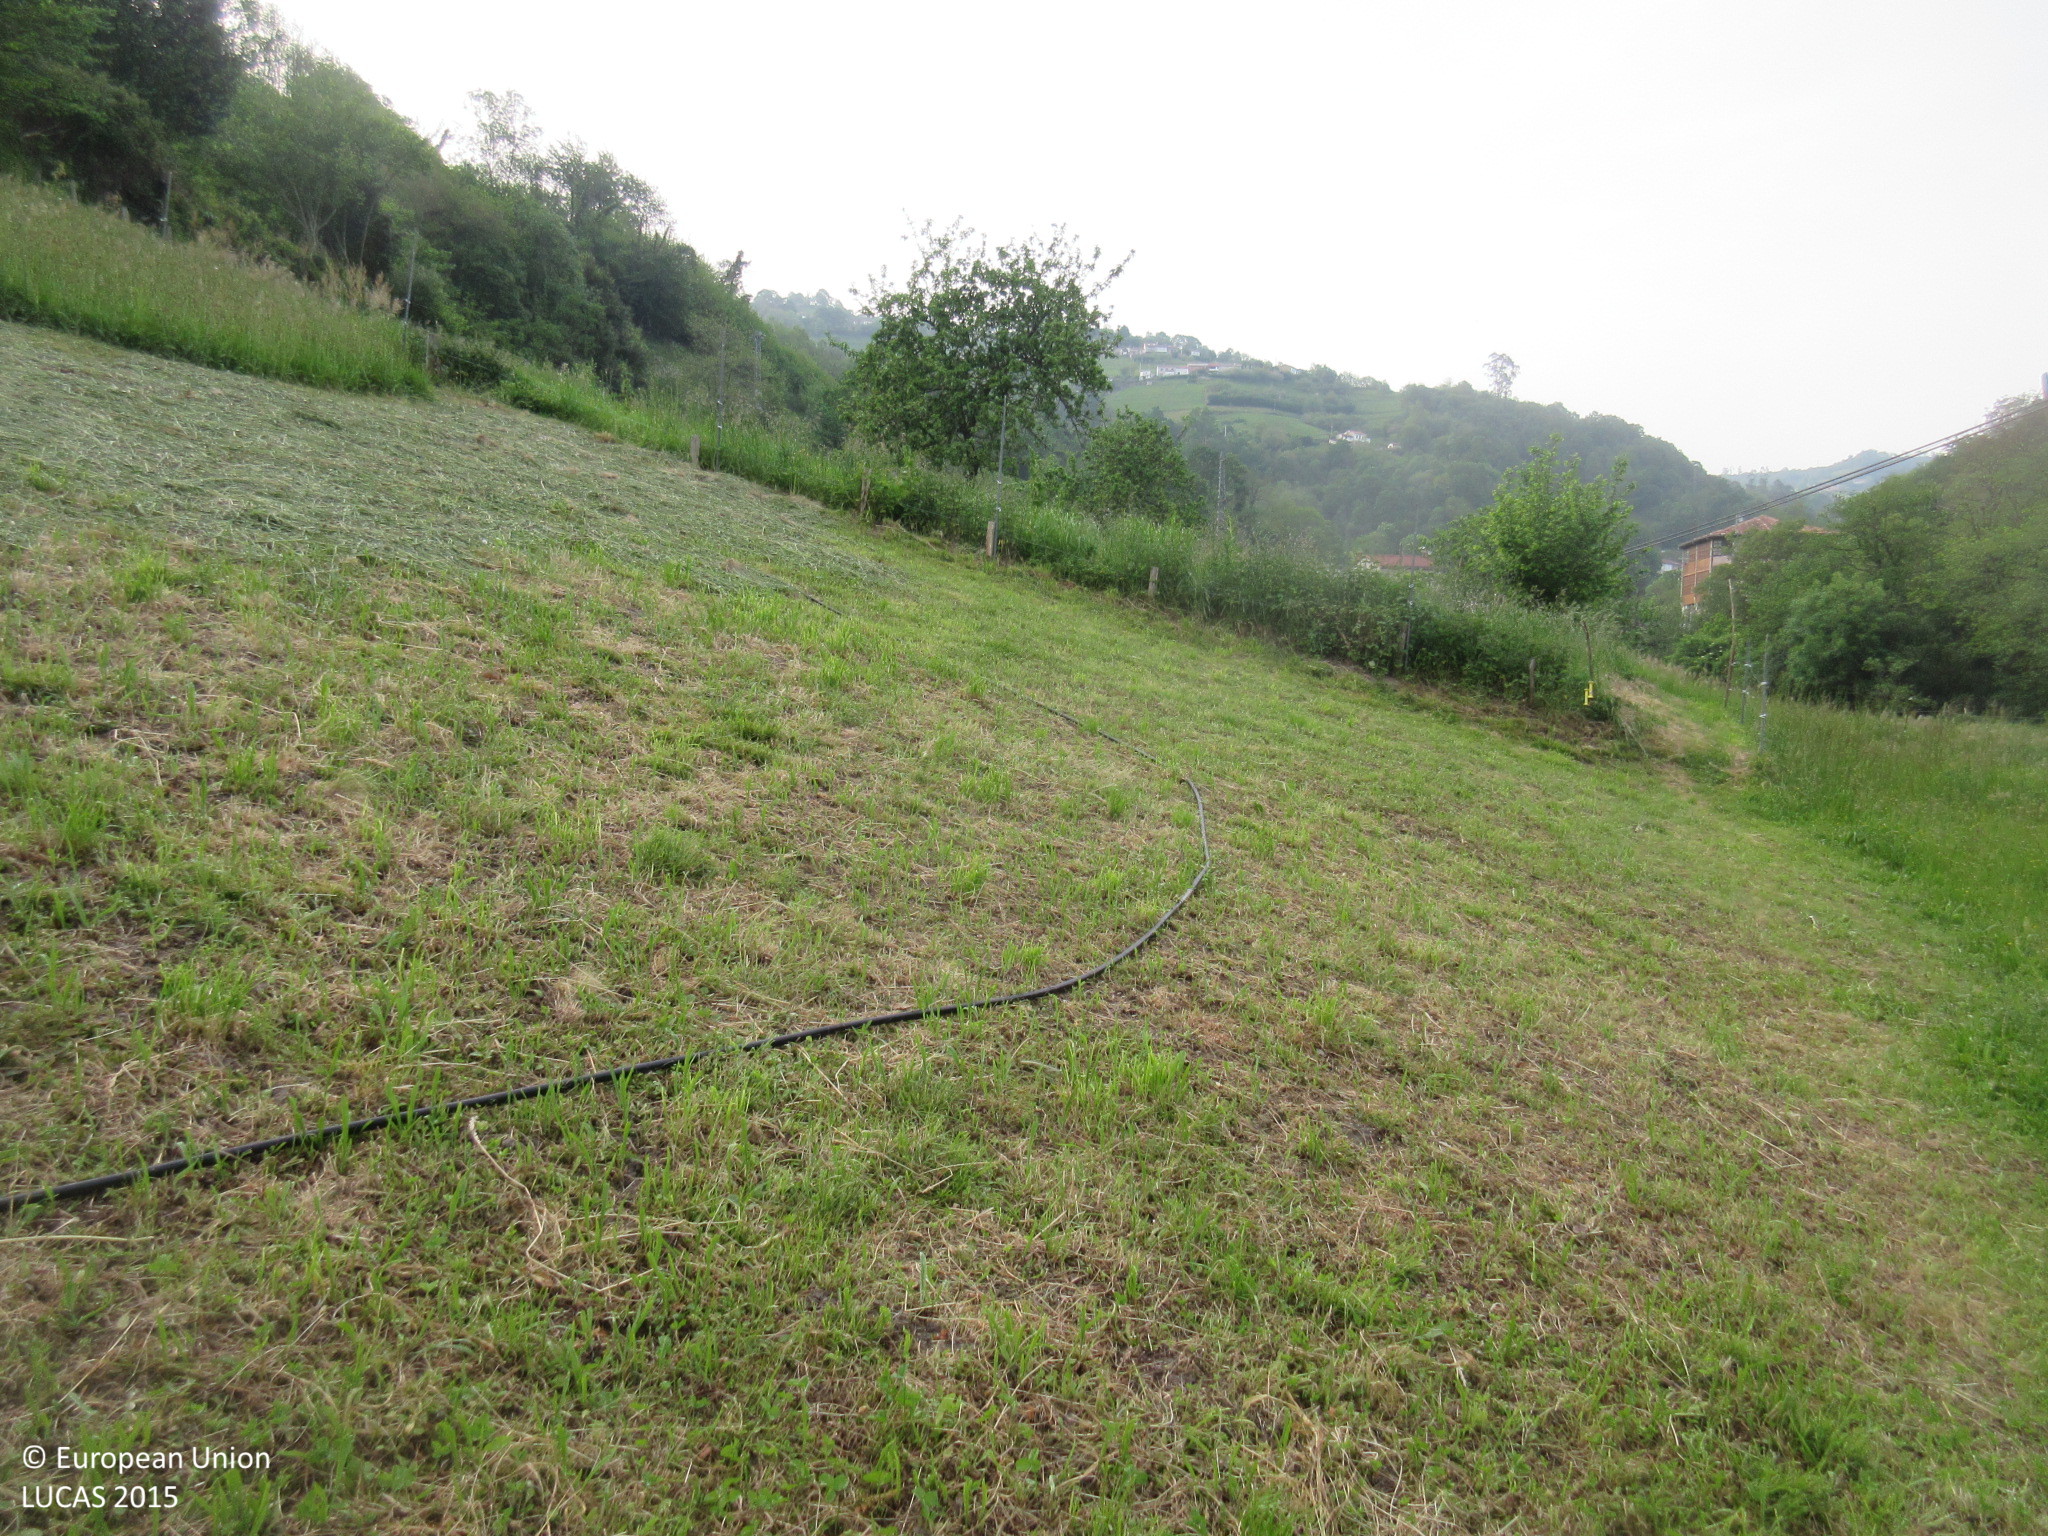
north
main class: Grassland
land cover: Grassland without tree/shrub cover
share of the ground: > 75 %
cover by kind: herbaceous plants 100 %
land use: Agriculture (excluding fallow land and kitchen gardens)
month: May
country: ES
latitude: 43.3083
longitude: -5.6033
